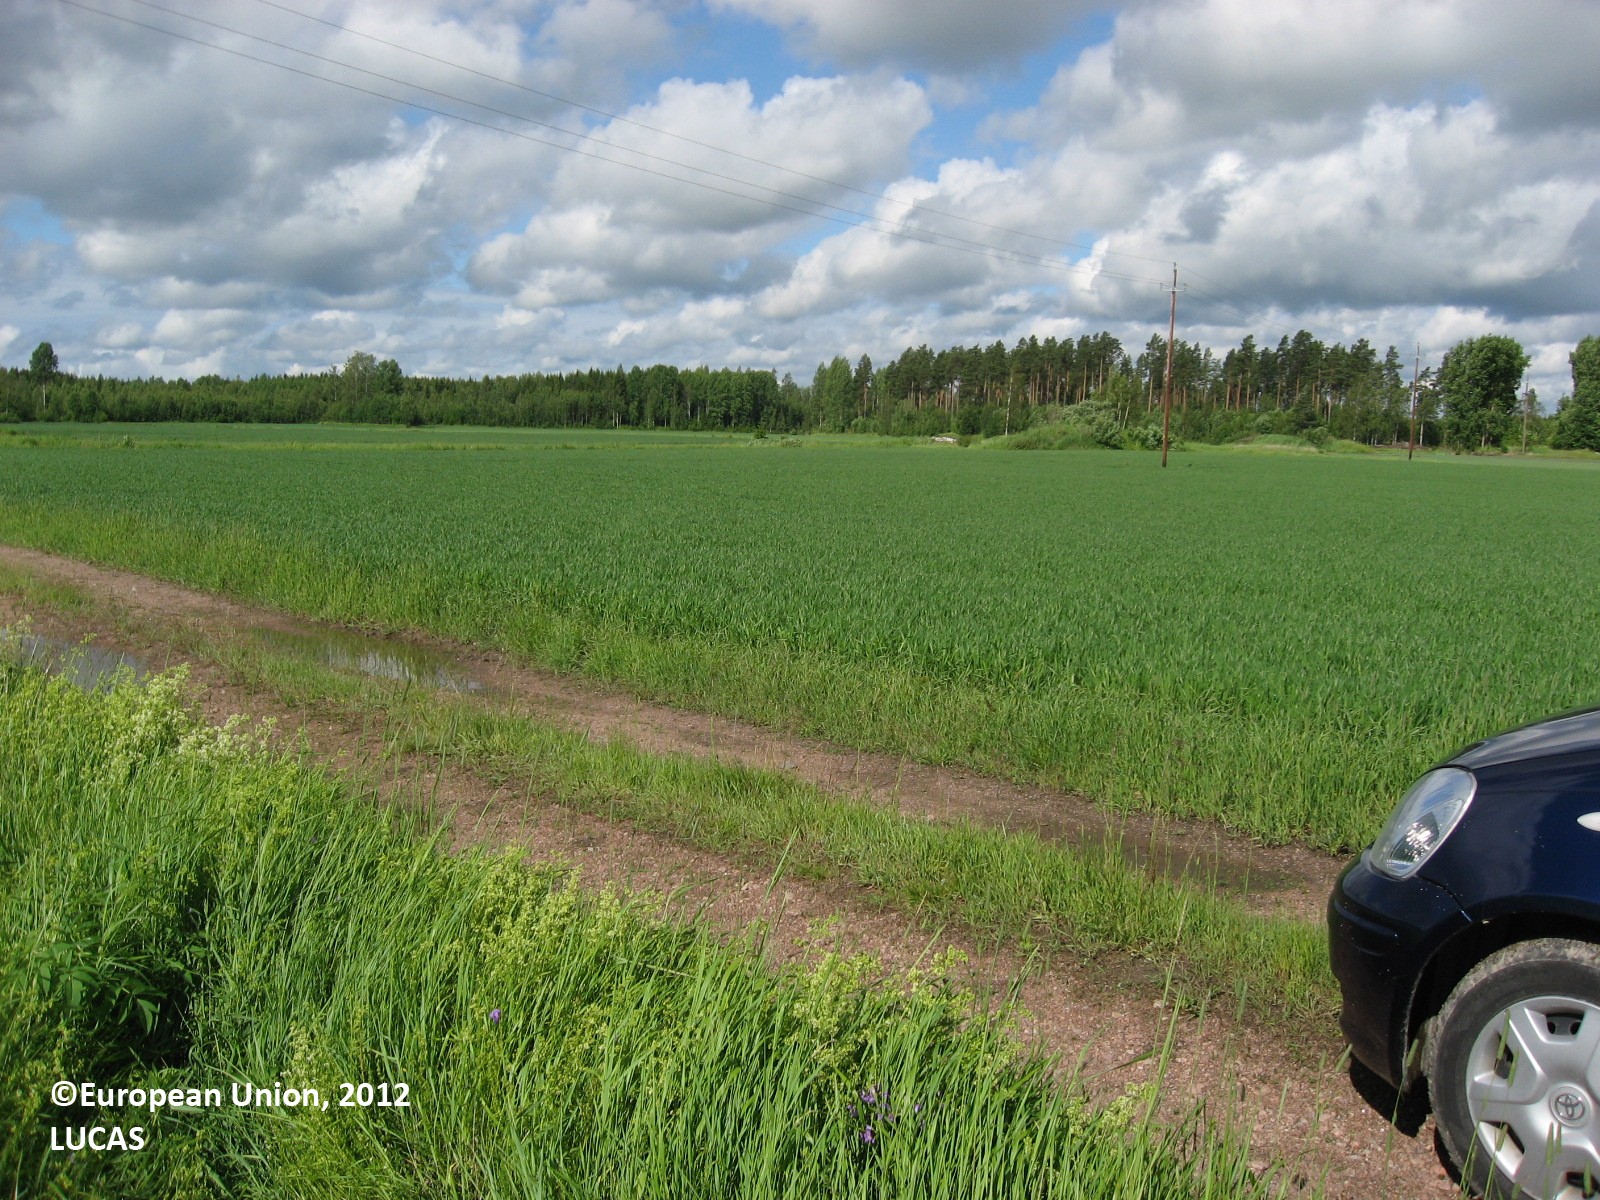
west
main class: Cropland
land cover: Barley
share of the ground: 50 - 75 %
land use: Agriculture (excluding fallow land and kitchen gardens)
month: June
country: FI
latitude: 60.5789
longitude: 26.3760
